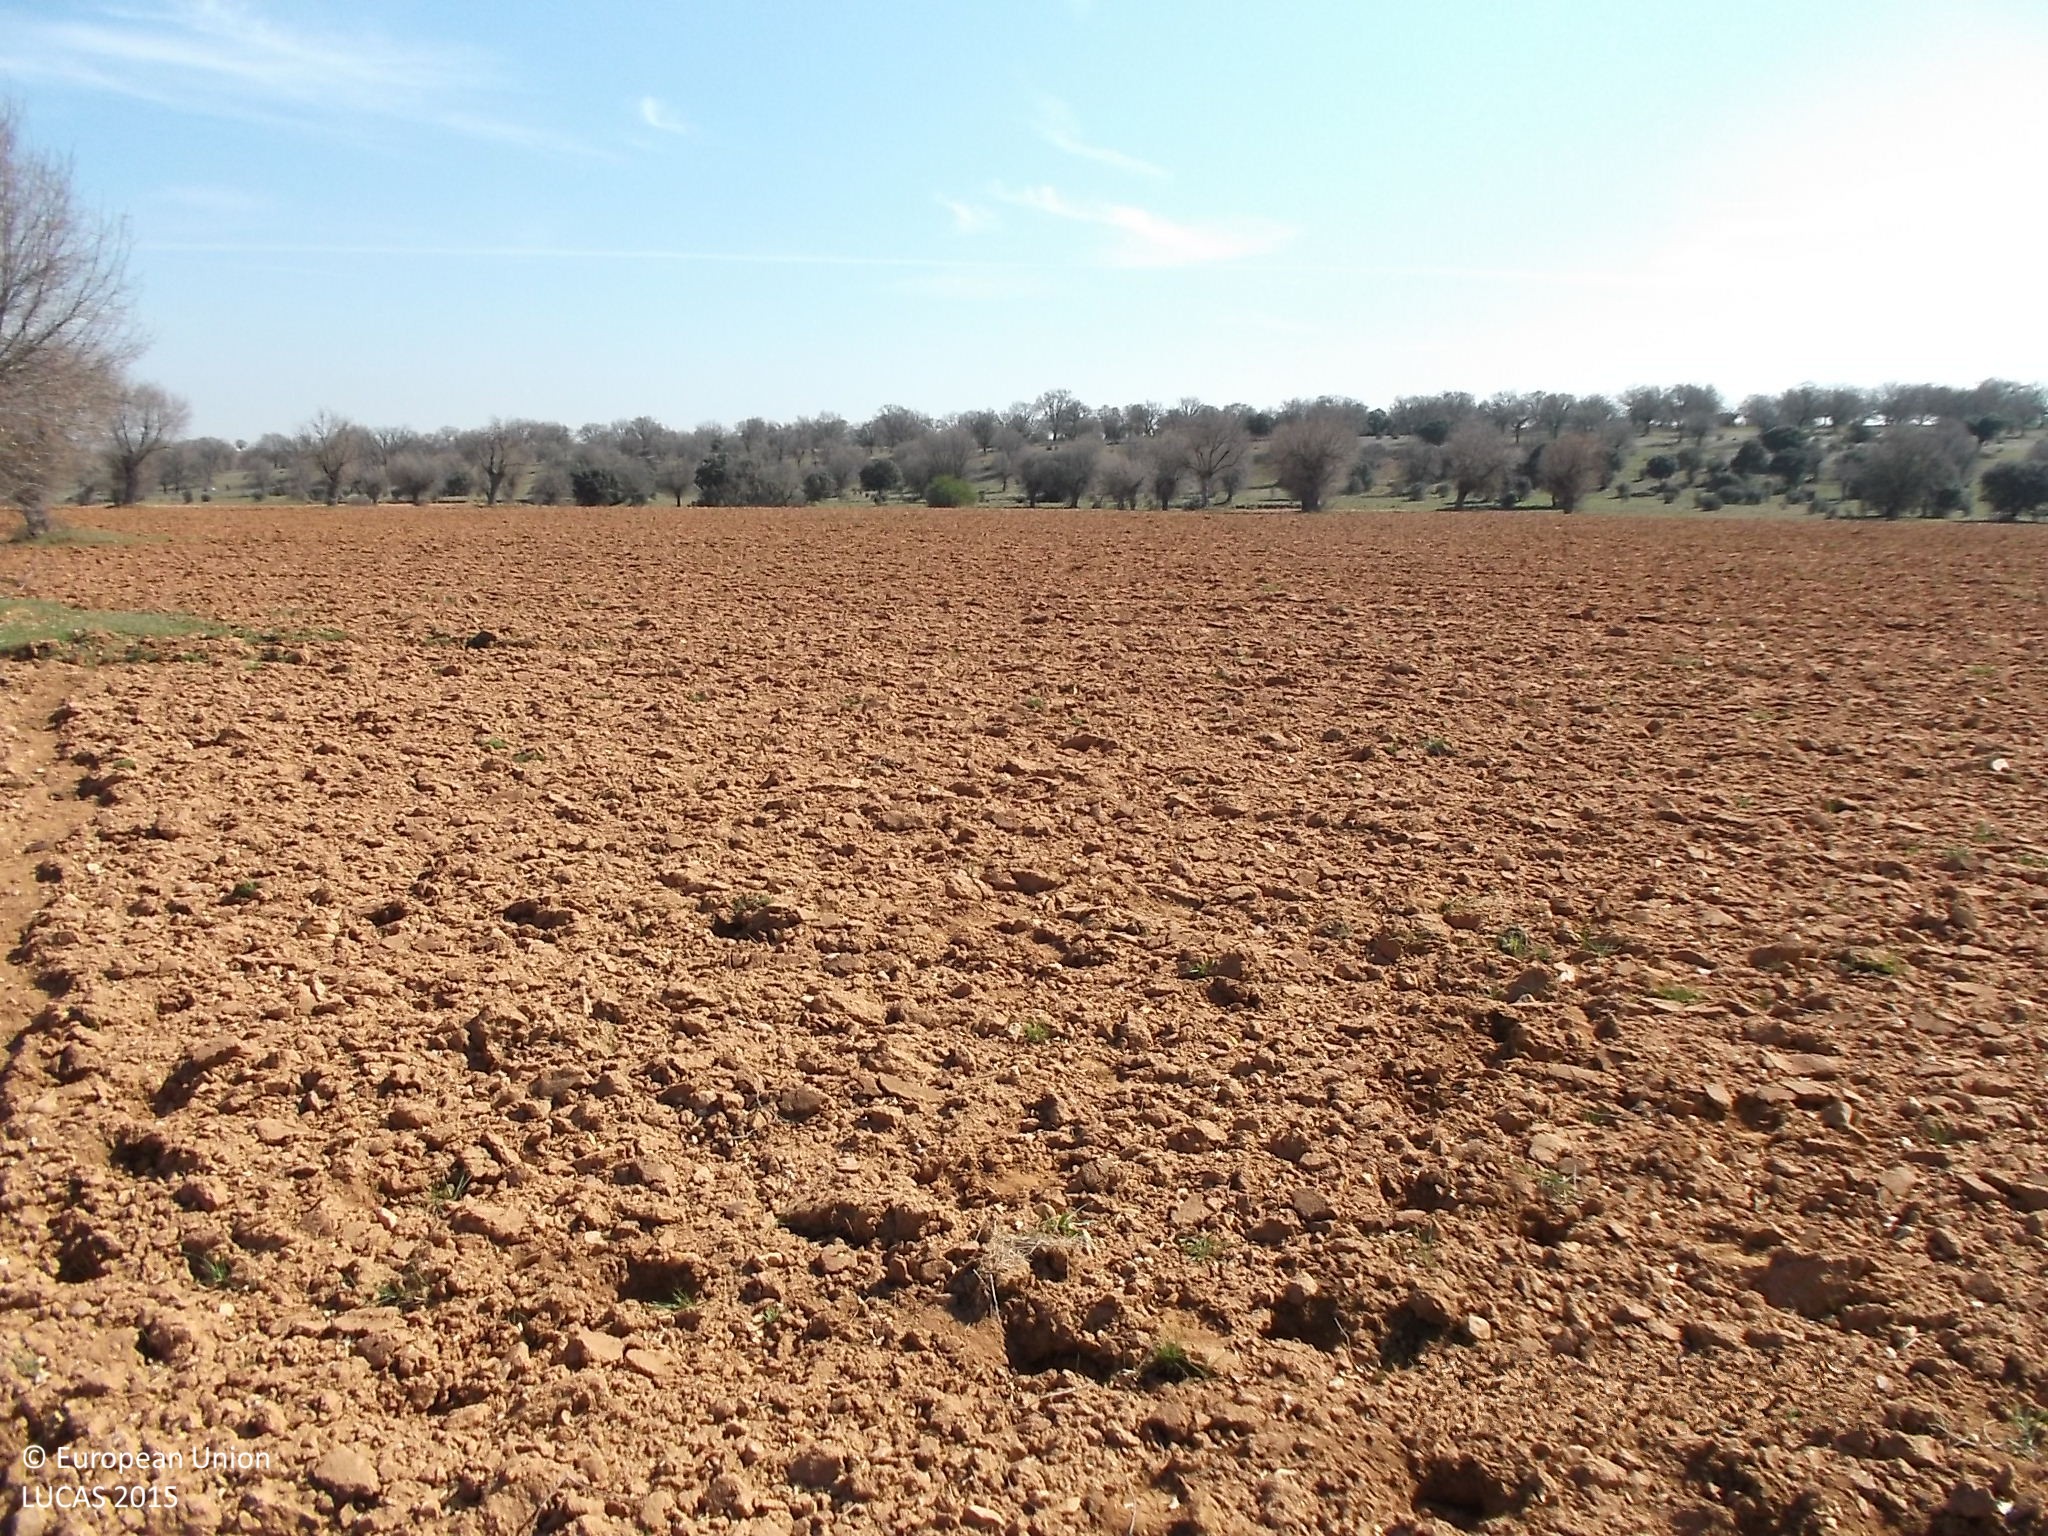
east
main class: Woodland
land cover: Broadleaved woodland
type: broadleaved evergreen forest
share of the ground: 10 - 25 %
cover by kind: unconsolidated bare surface 85 %, broadleaved forest trees 15 %
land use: Forestry
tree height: < 5 m
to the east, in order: Broadleaved woodland; Other bare soil; Grassland with sparse tree/shrub cover; Inland fresh running water; Broadleaved woodland
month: April
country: ES
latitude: 40.8568
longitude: -5.8934
